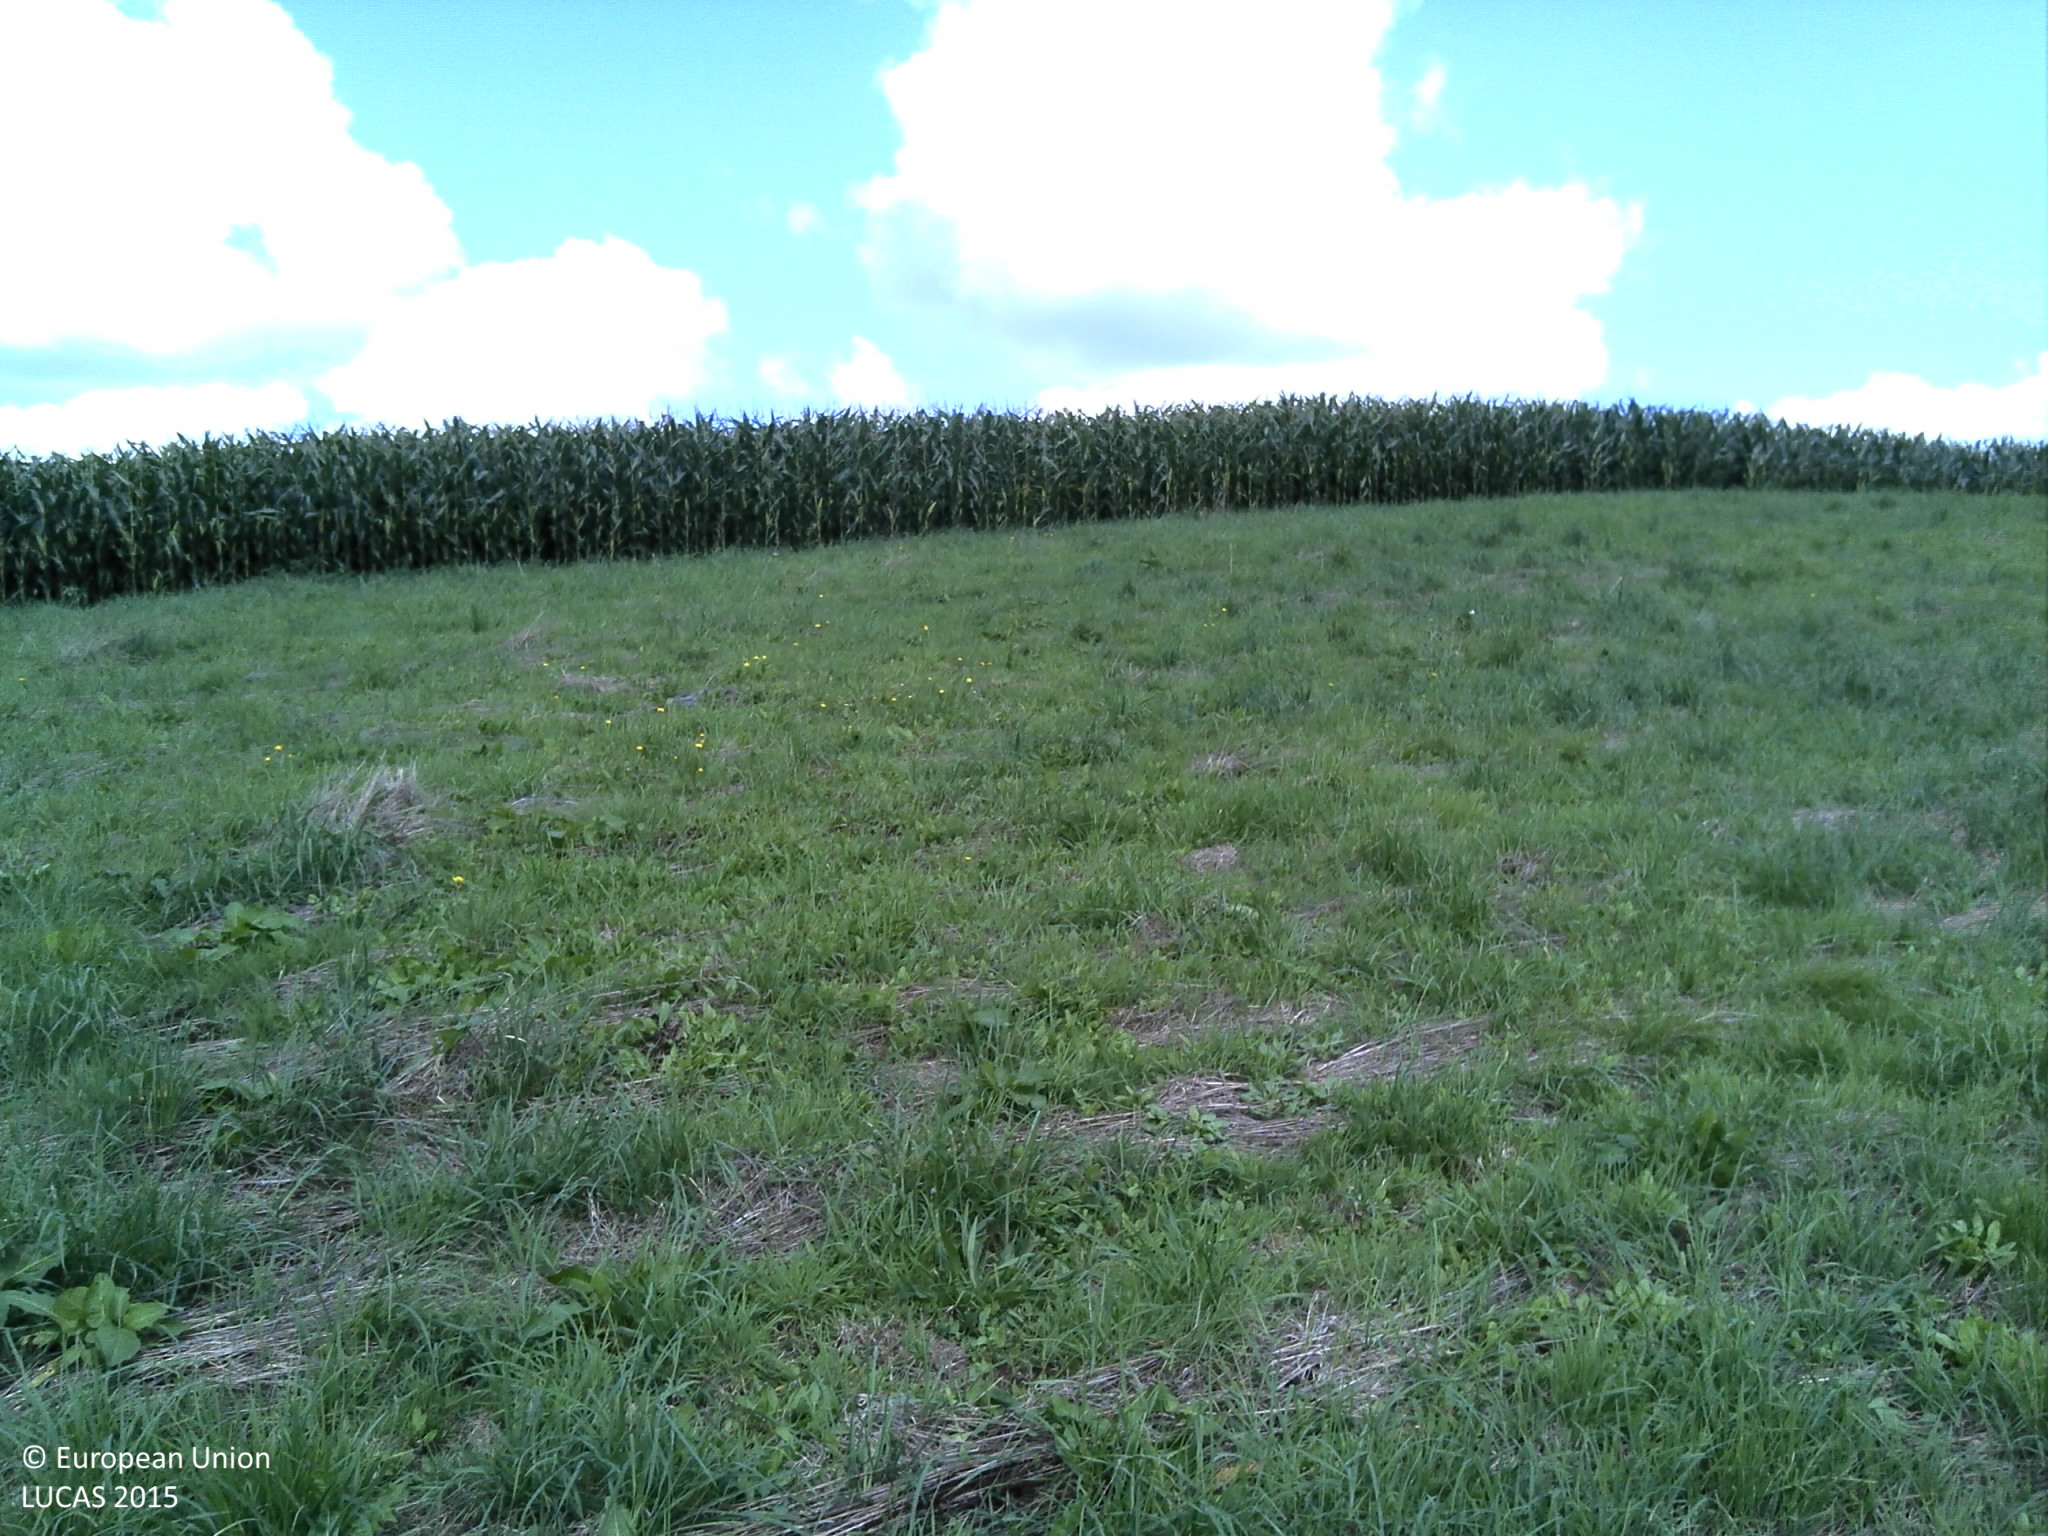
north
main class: Grassland
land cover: Grassland without tree/shrub cover
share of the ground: > 75 %
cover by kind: herbaceous plants 100 %
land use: Agriculture (excluding fallow land and kitchen gardens)
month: September
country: FR
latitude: 48.3972
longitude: -4.1790
